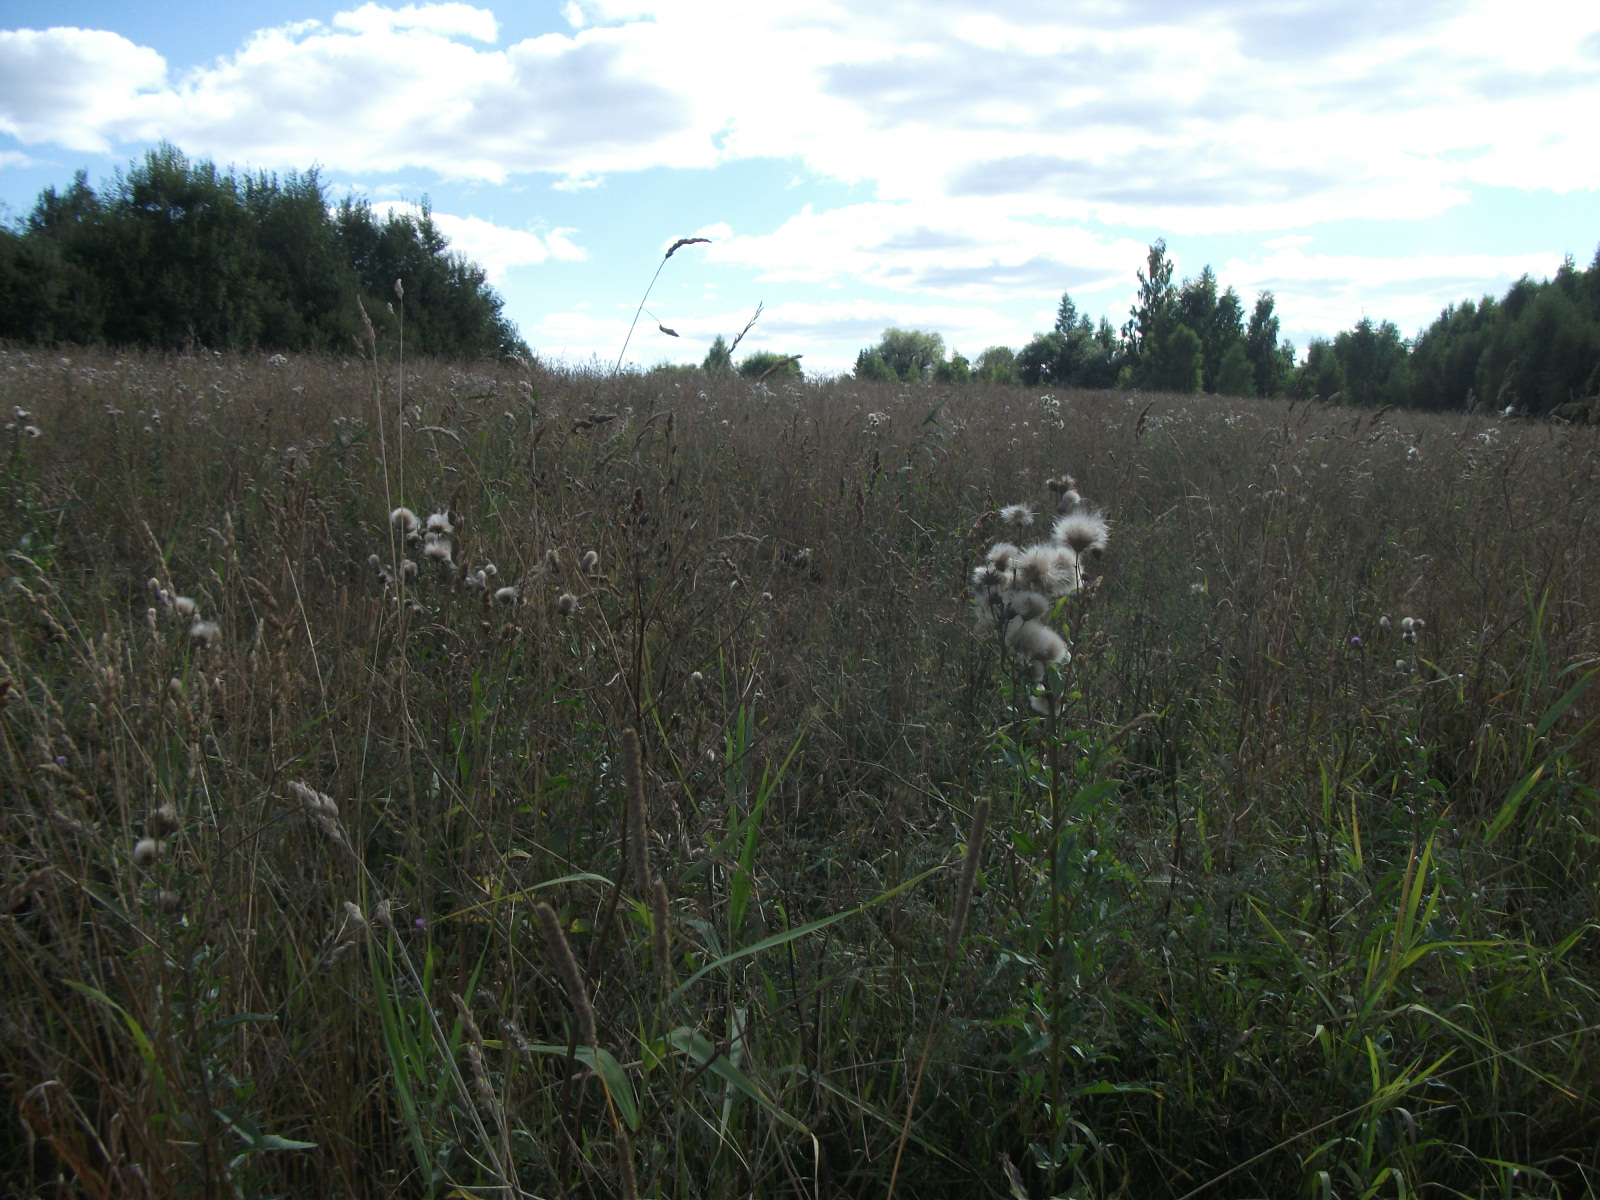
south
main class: Grassland
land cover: Spontaneously vegetated surfaces
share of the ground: > 75 %
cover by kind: herbaceous plants 95 %, shrubs 5 %
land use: Semi-natural and natural areas not in use
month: August
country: LV
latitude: 56.4176
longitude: 26.3374
